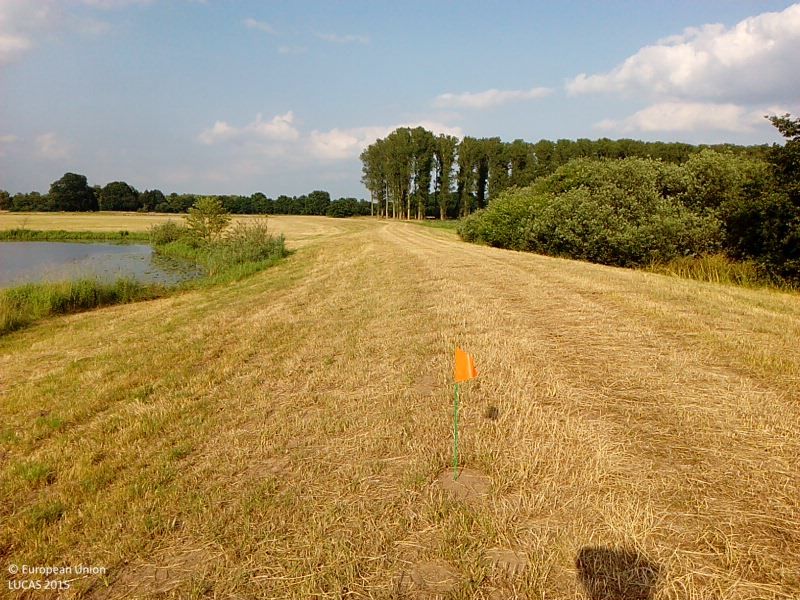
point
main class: Grassland
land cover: Grassland without tree/shrub cover
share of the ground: > 75 %
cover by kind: herbaceous plants 100 %
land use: Agriculture (excluding fallow land and kitchen gardens)
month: July
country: DE
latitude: 52.6730
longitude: 7.4123
